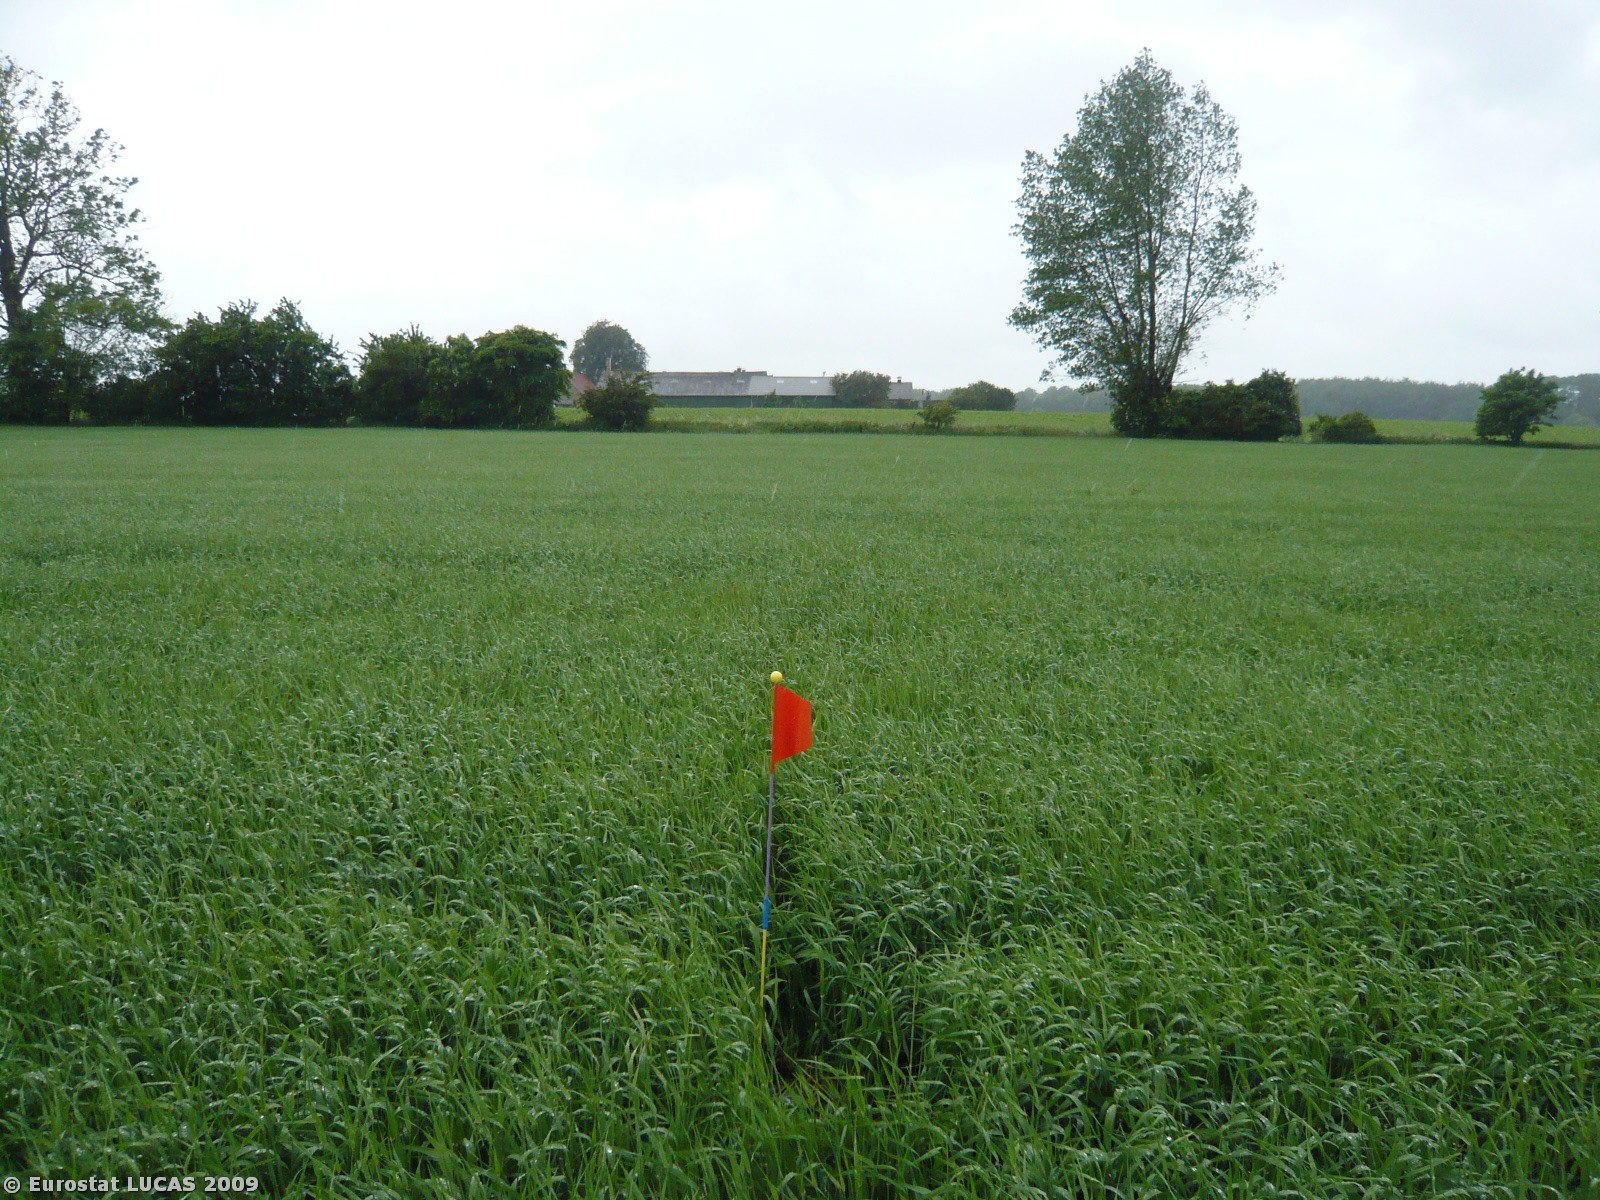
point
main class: Cropland
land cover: Barley
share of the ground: > 75 %
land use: Agriculture (excluding fallow land and kitchen gardens)
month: June
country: DK
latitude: 54.7891
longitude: 11.9116
